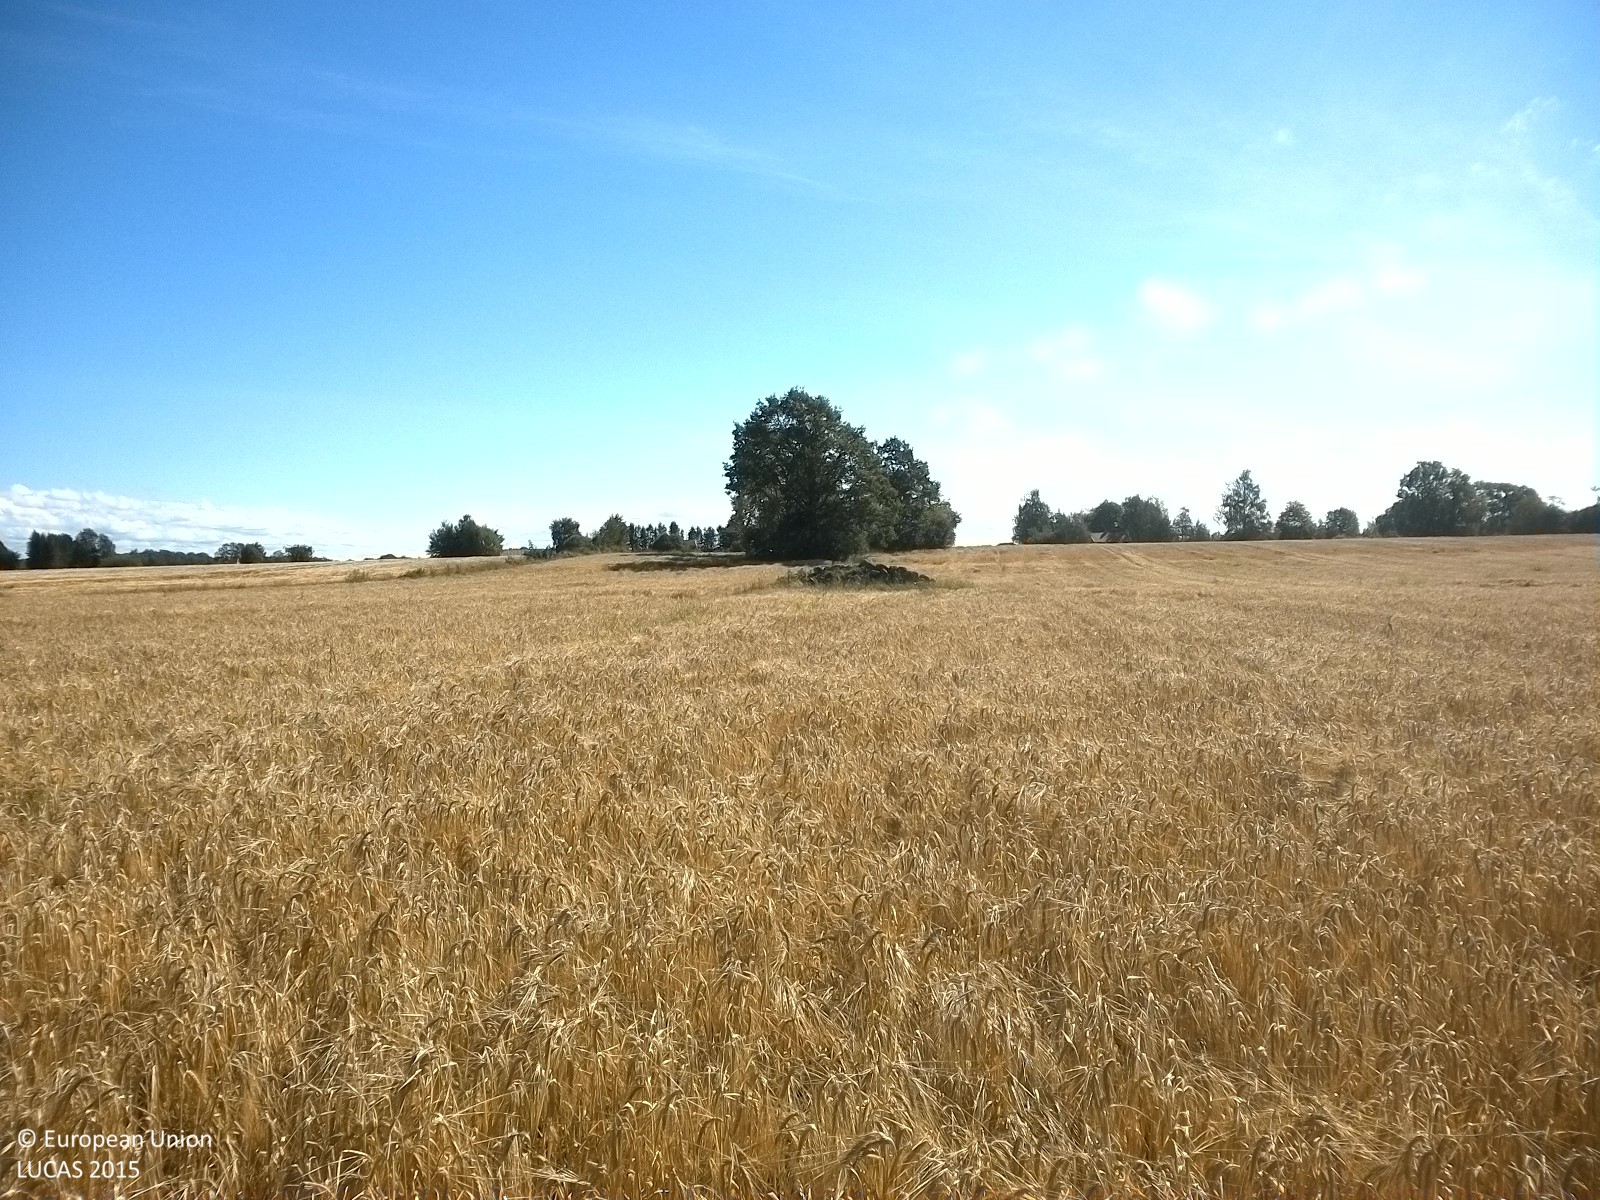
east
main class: Cropland
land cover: Barley
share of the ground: > 75 %
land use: Agriculture (excluding fallow land and kitchen gardens)
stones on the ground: < 10 %
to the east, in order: Barley; Broadleaved woodland; Barley; Grass margins; Dry stone walls; Grass margins; Oats
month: August
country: SE
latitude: 59.2055
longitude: 15.5434
